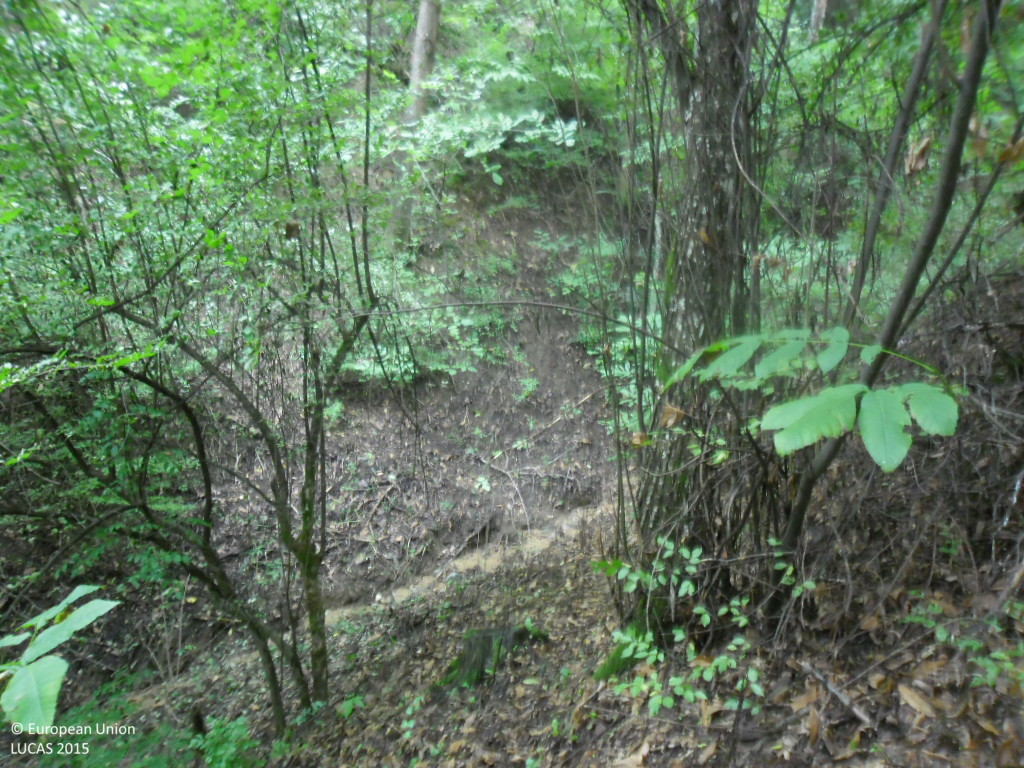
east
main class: Woodland
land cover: Broadleaved woodland
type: mesophytic deciduous forest
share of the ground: > 75 %
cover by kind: broadleaved forest trees 95 %, unconsolidated bare surface 5 %
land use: Forestry
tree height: > 5 m
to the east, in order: Broadleaved woodland; Rivers and streams; Pine dominated mixed woodland; Pine dominated coniferous woodland; Broadleaved woodland; Pine dominated coniferous woodland; Pine dominated mixed woodland
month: September
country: BG
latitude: 41.3659
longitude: 23.0595
